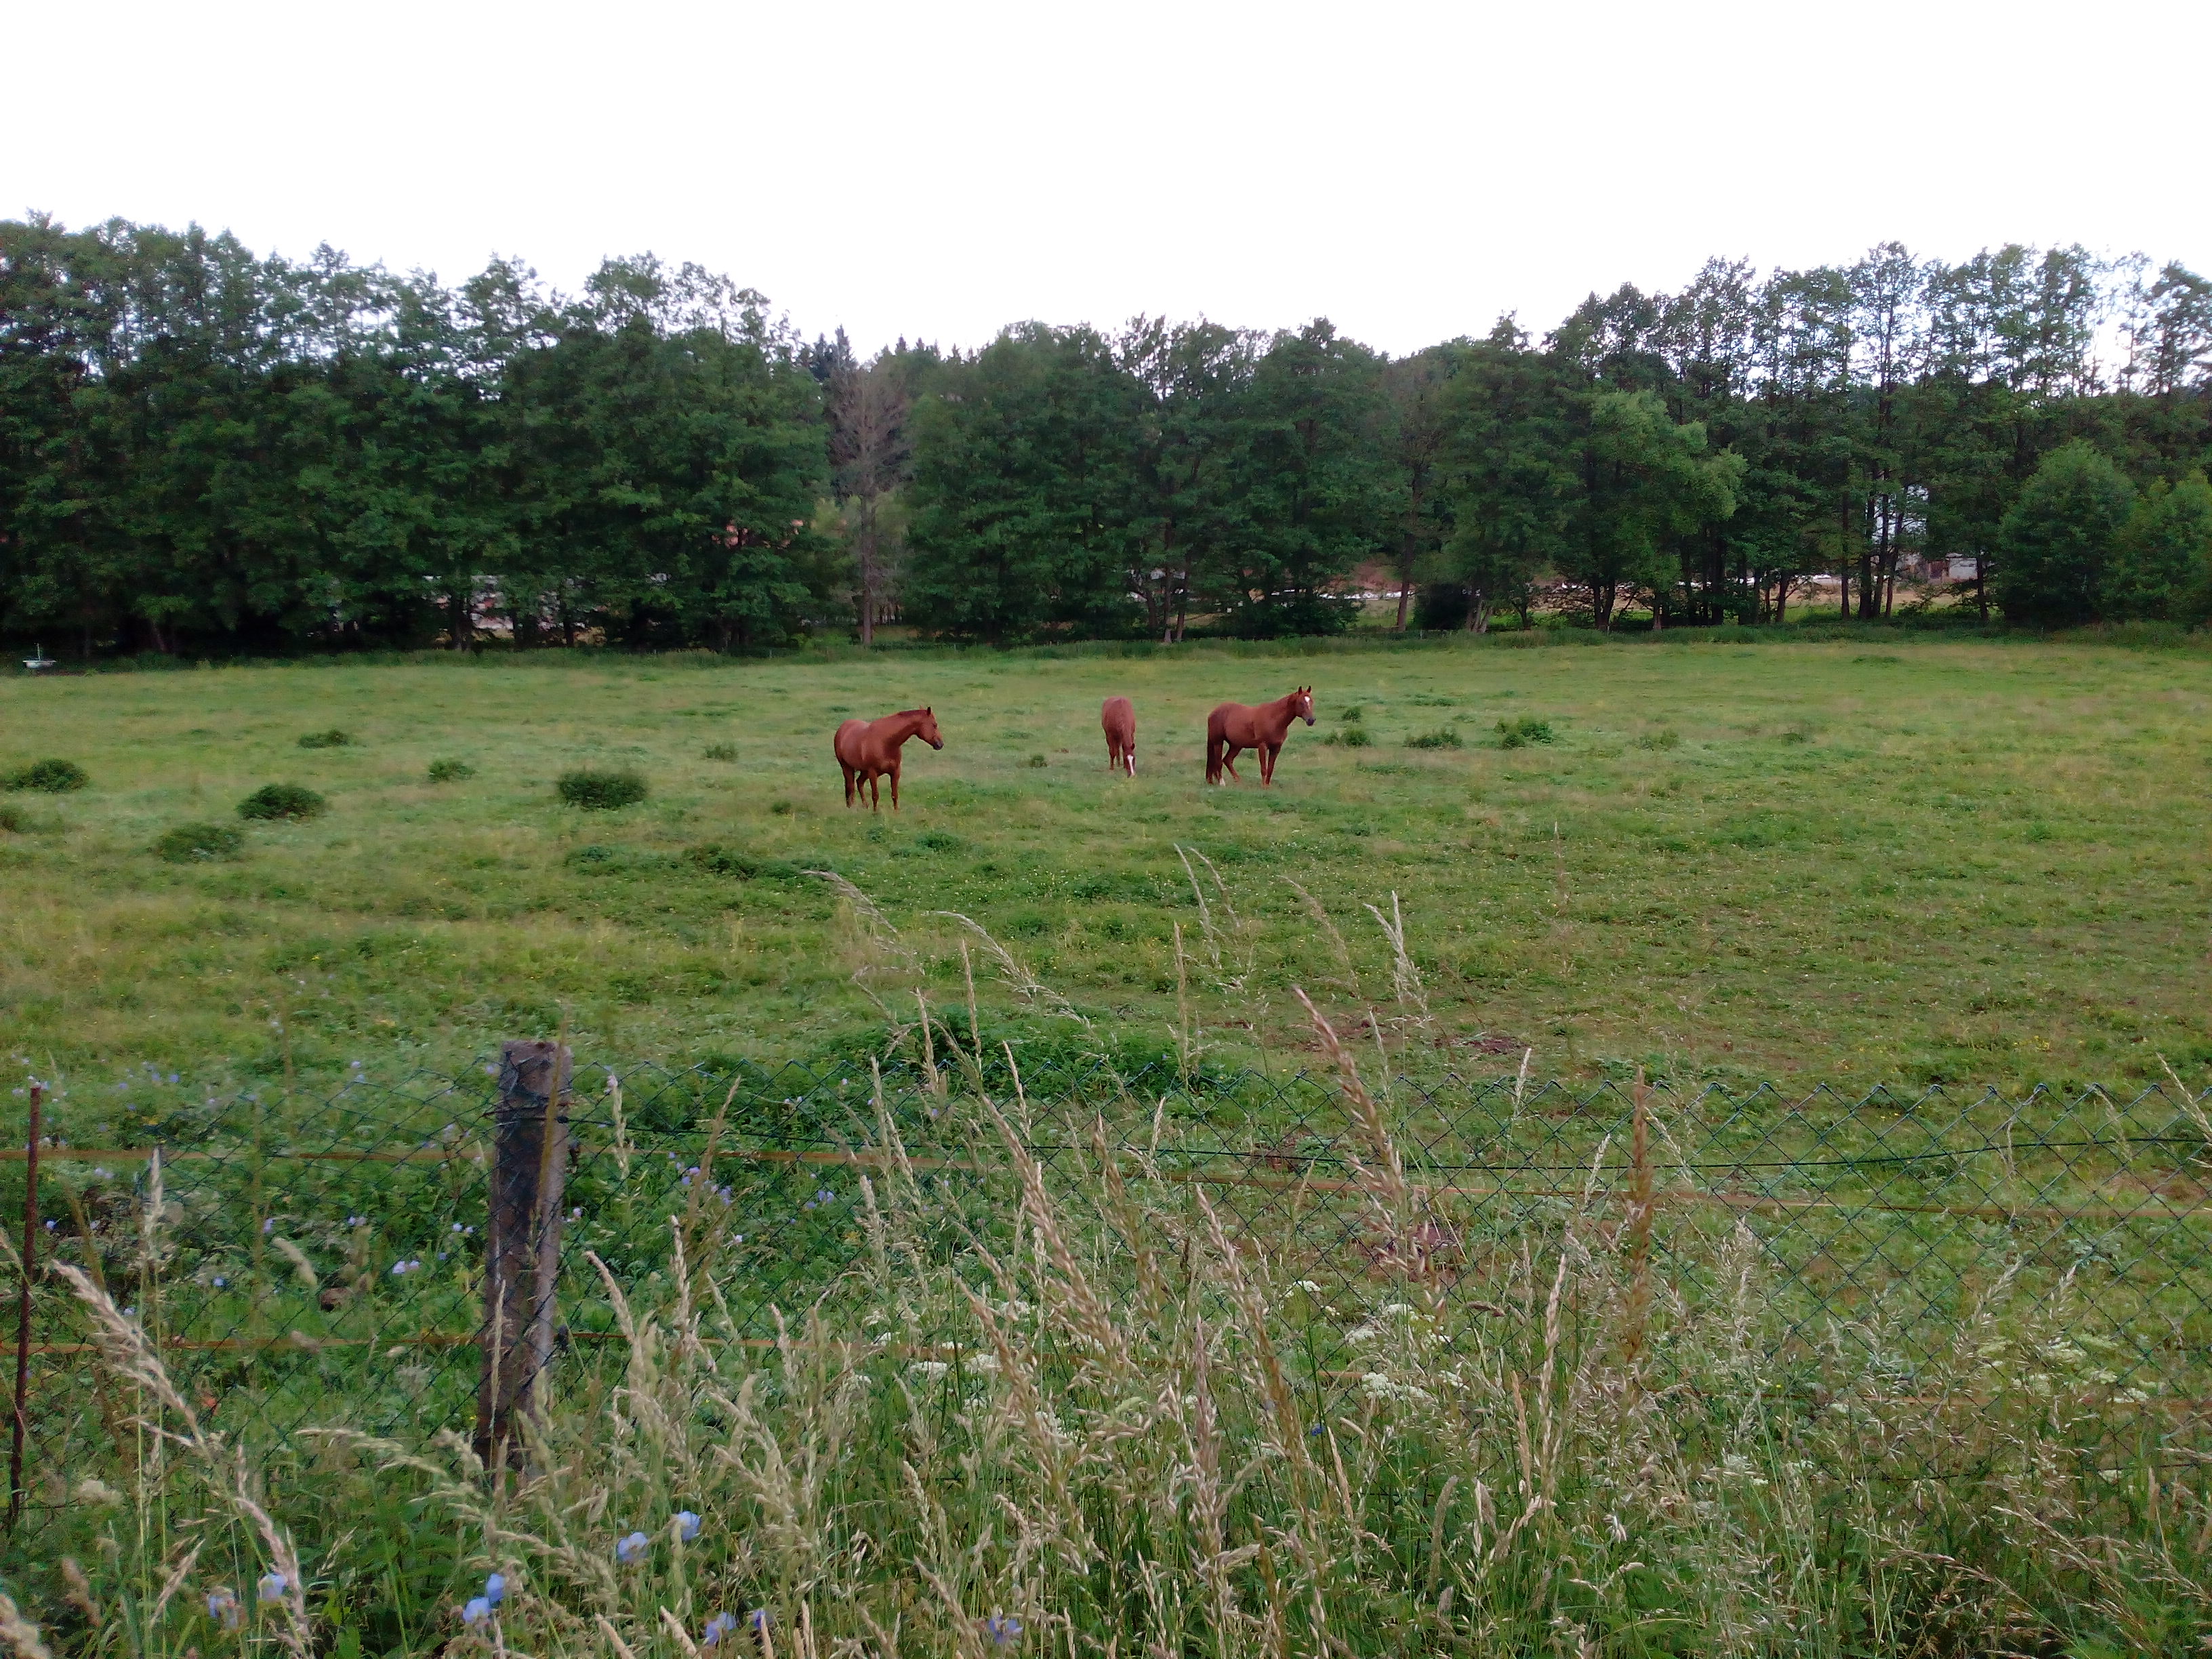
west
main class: Grassland
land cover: Grassland without tree/shrub cover
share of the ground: > 75 %
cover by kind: herbaceous plants 100 %
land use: Agriculture (excluding fallow land and kitchen gardens)
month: June
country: DE
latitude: 50.5061
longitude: 10.6343
